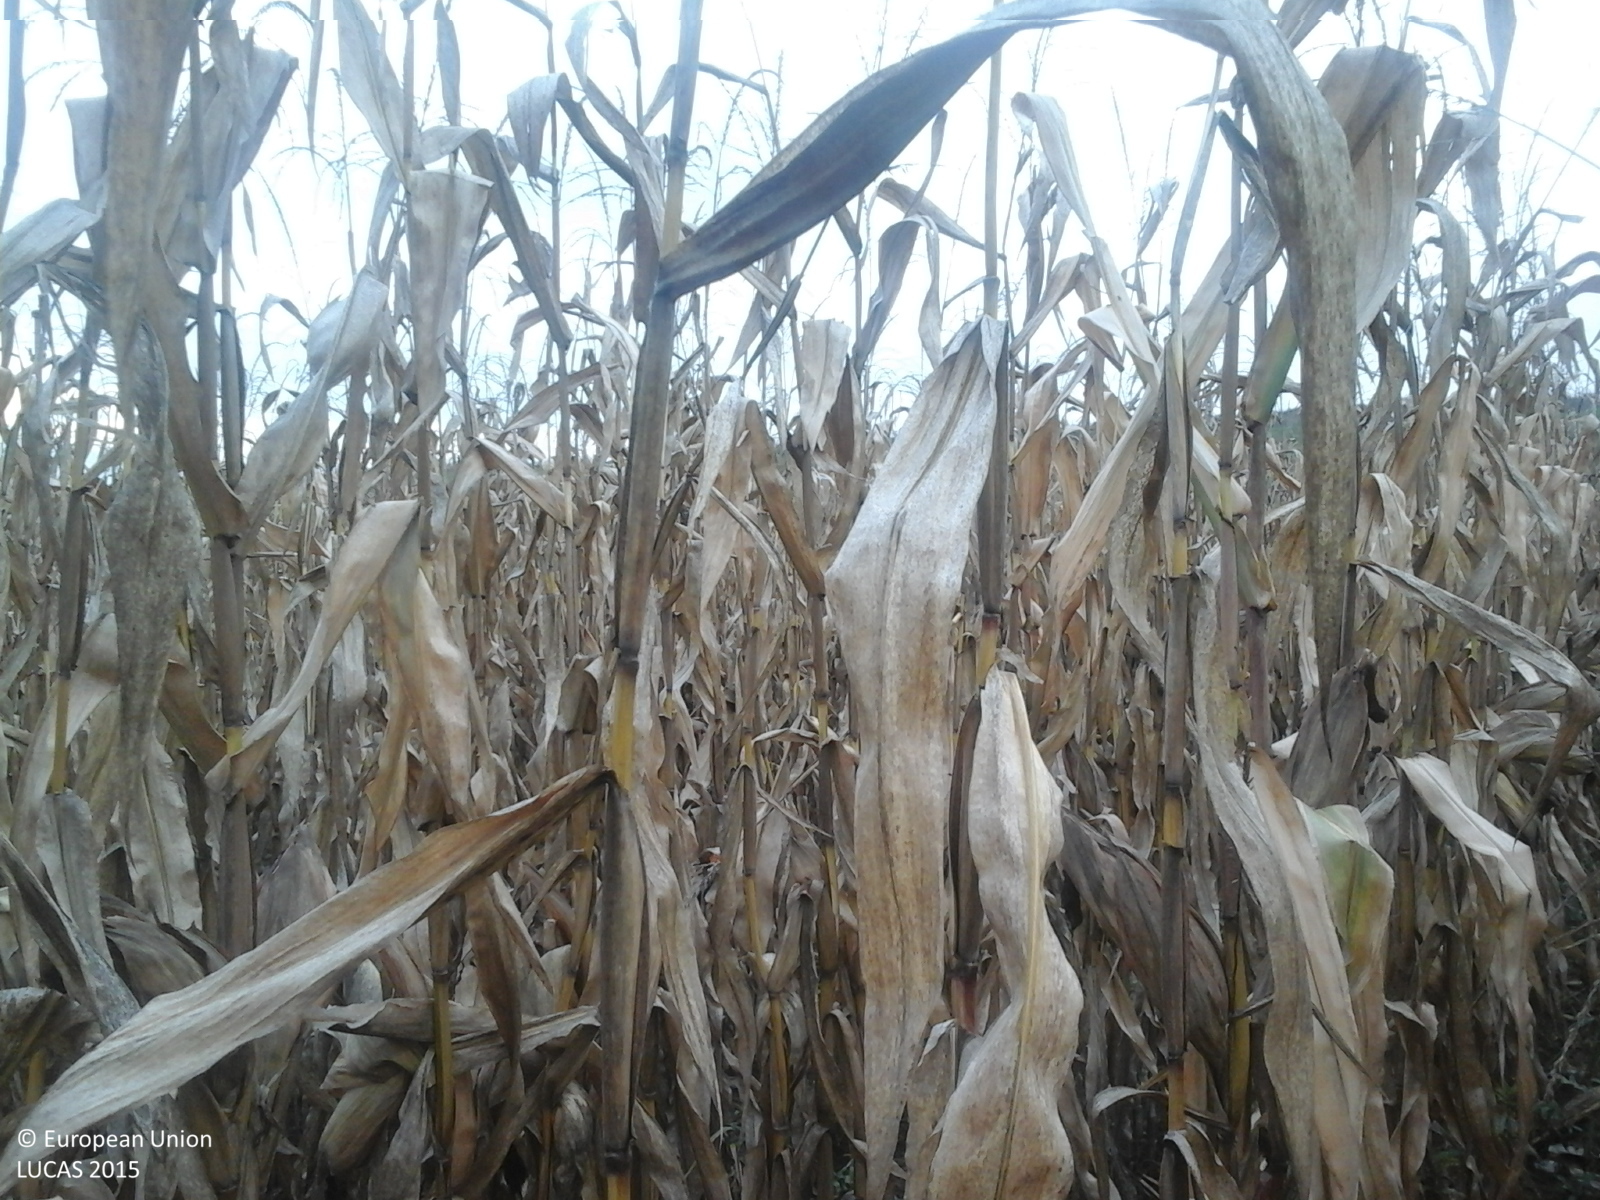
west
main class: Cropland
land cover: Maize
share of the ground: > 75 %
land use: Agriculture (excluding fallow land and kitchen gardens)
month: October
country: RO
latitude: 46.4496
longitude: 24.1256
